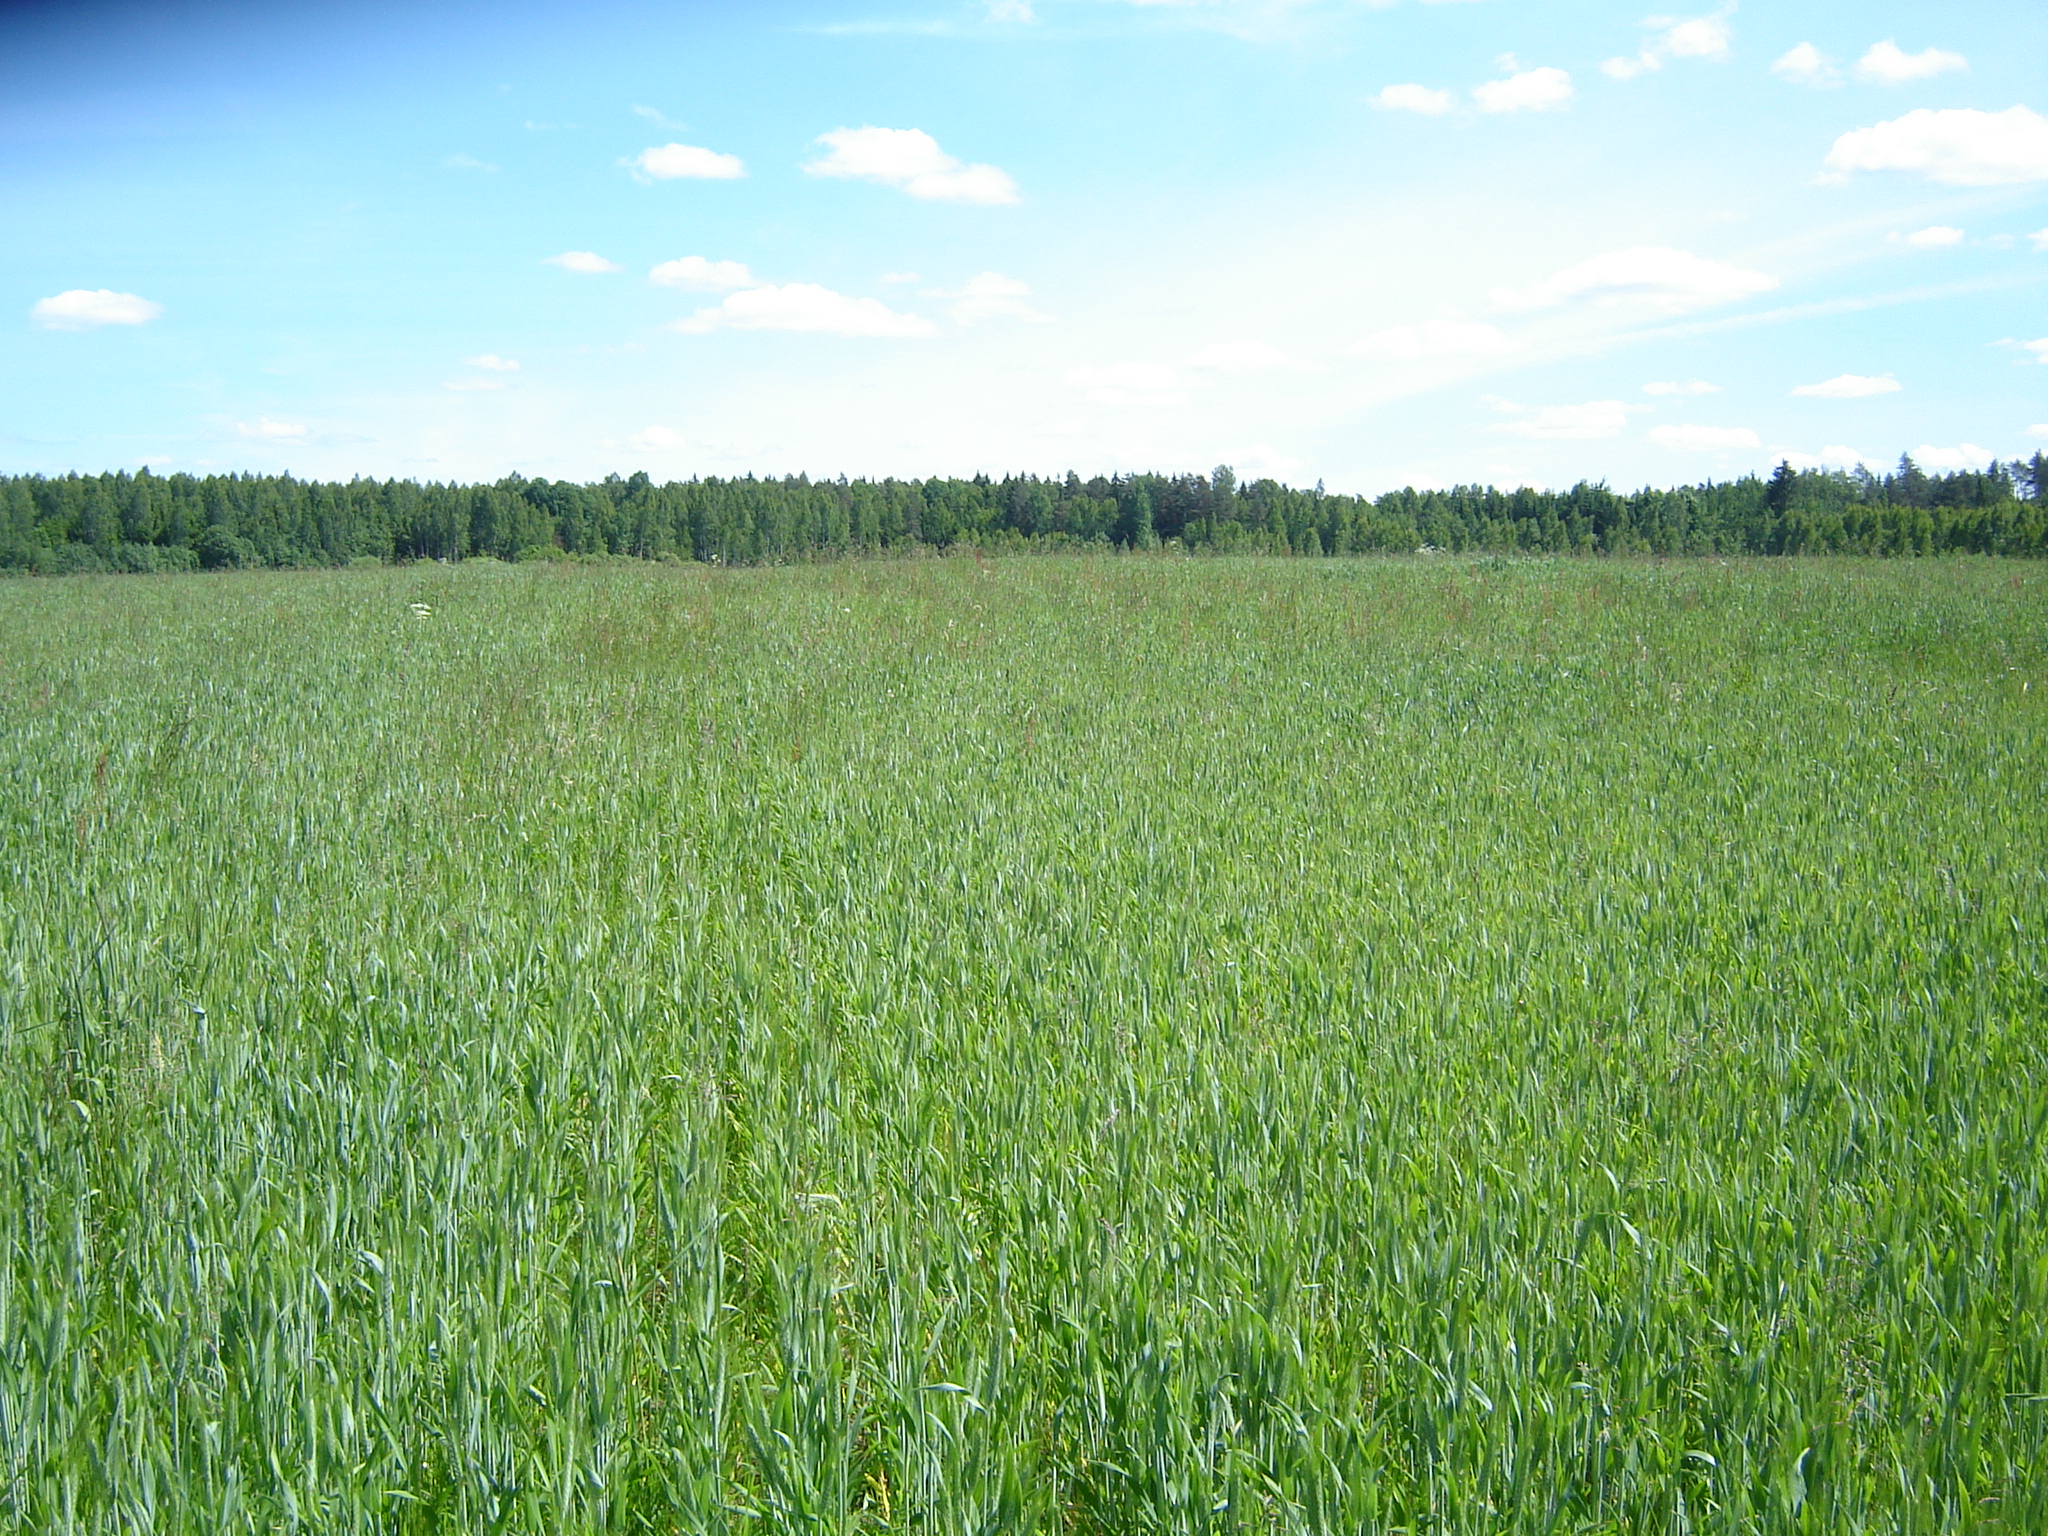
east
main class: Cropland
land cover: Rye
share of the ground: > 75 %
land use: Agriculture (excluding fallow land and kitchen gardens)
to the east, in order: Rye; Grassland without tree/shrub cover; Tracks; Grassland without tree/shrub cover
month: June
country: LT
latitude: 55.6745
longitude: 25.0760
